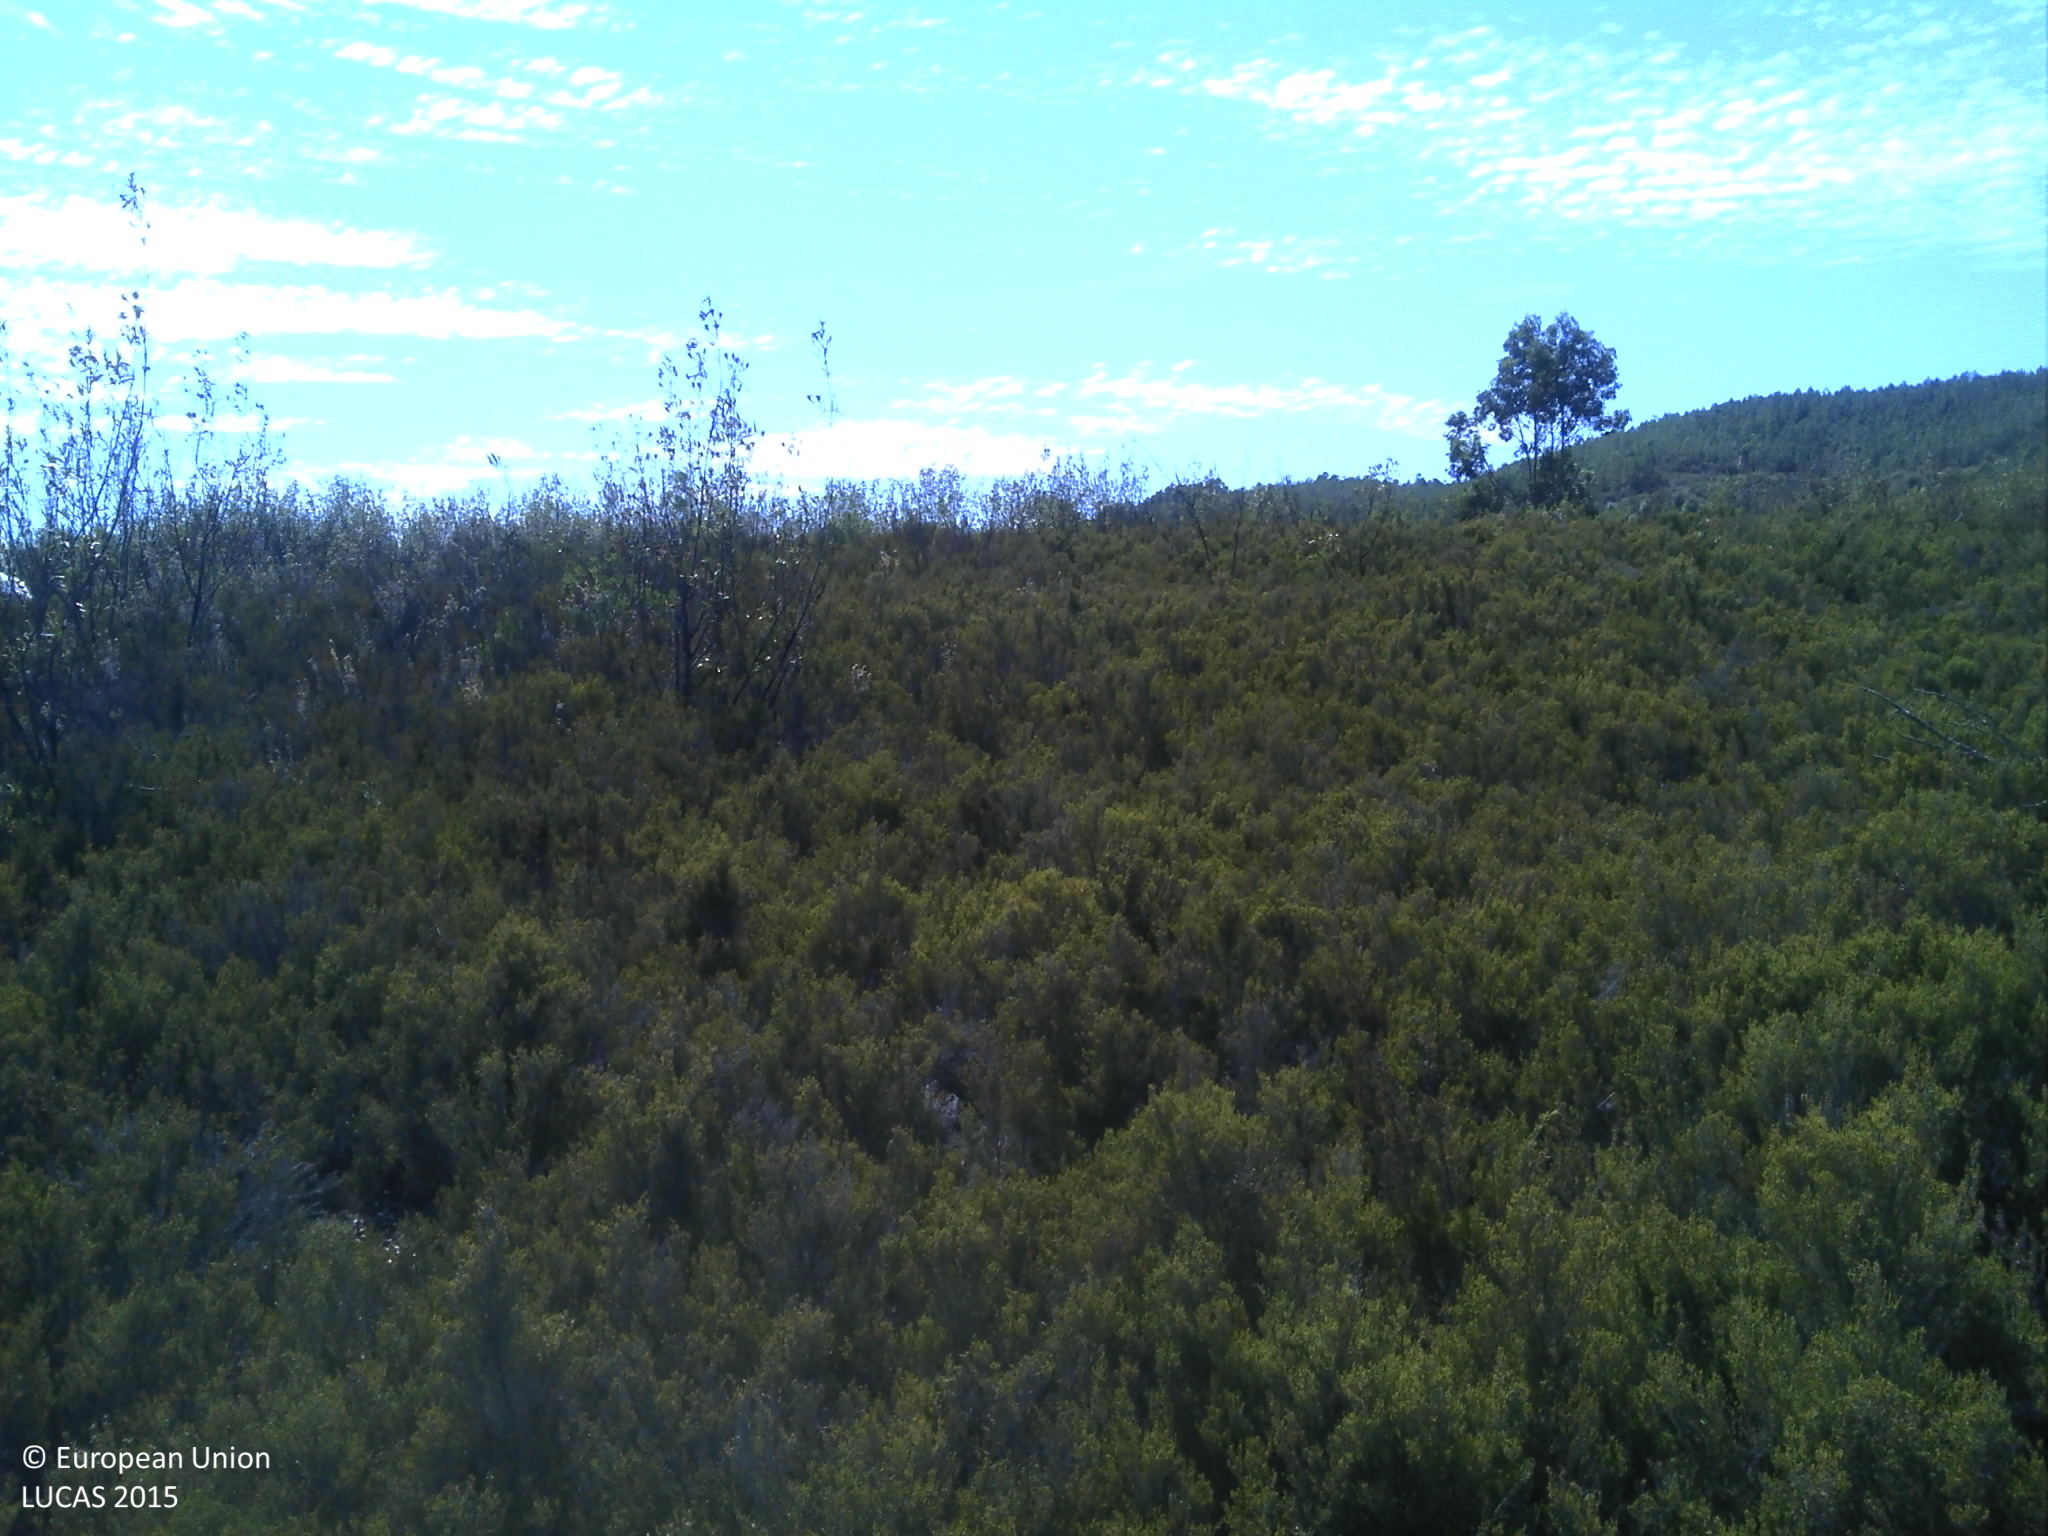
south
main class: Shrubland
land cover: Shrubland without tree cover
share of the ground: > 75 %
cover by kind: shrubs 80 %, unconsolidated bare surface 20 %
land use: Abandoned areas
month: July
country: PT
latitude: 40.1687
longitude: -7.6399
